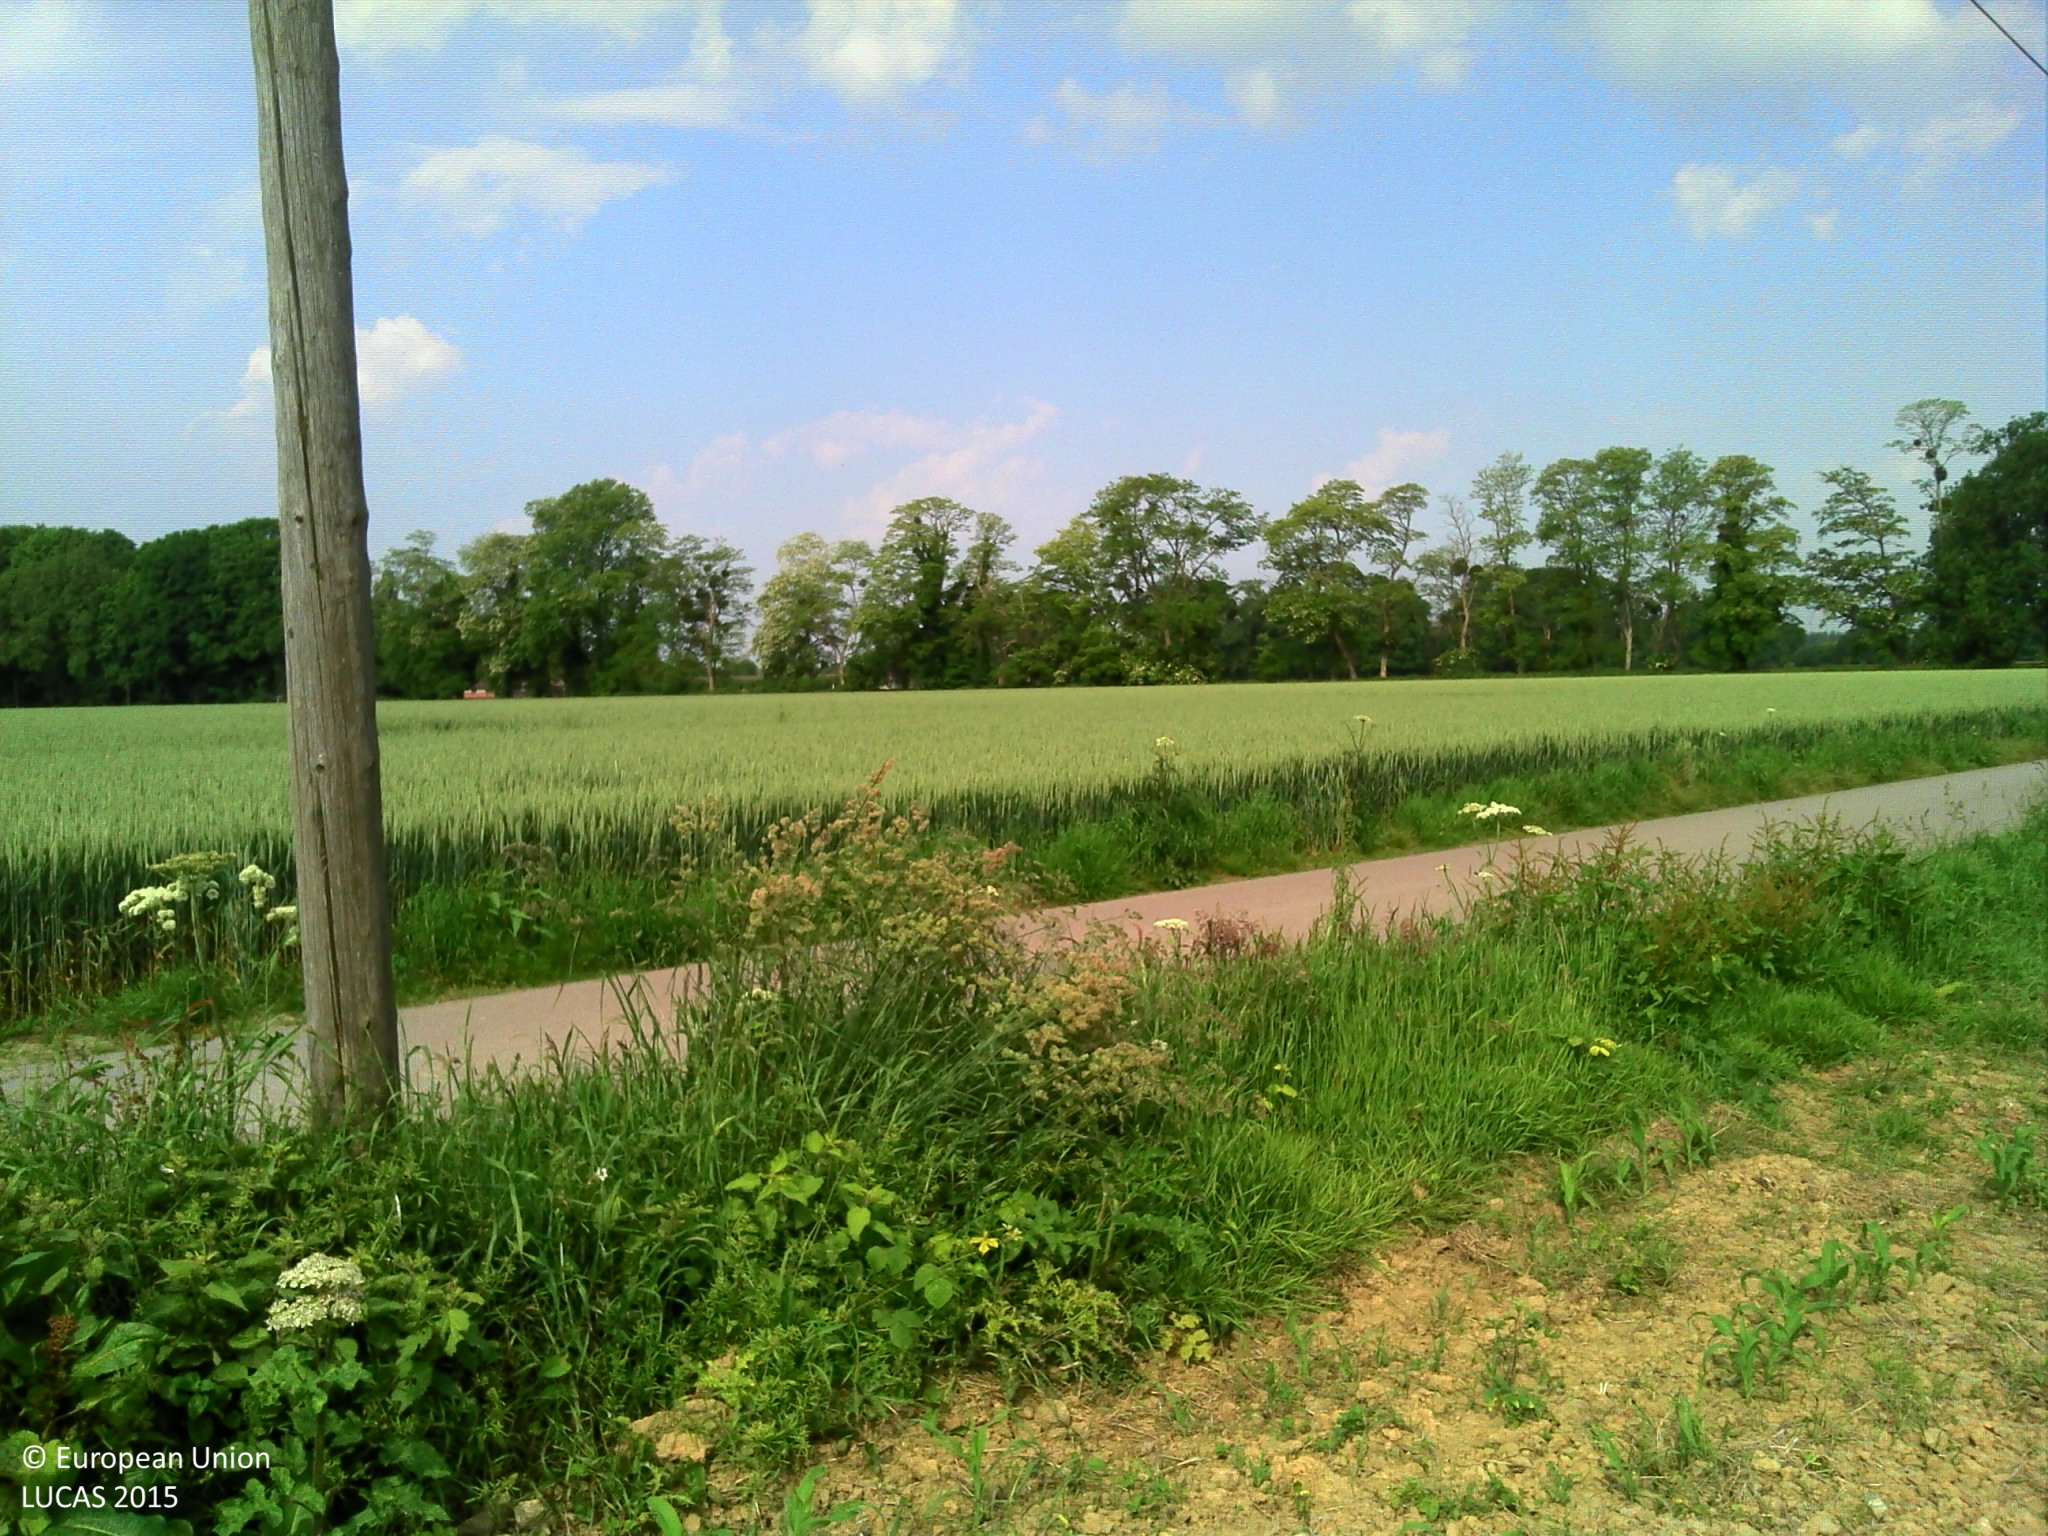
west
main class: Cropland
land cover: Maize
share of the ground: 10 - 25 %
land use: Agriculture (excluding fallow land and kitchen gardens)
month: June
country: FR
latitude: 49.2124
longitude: 0.3494
